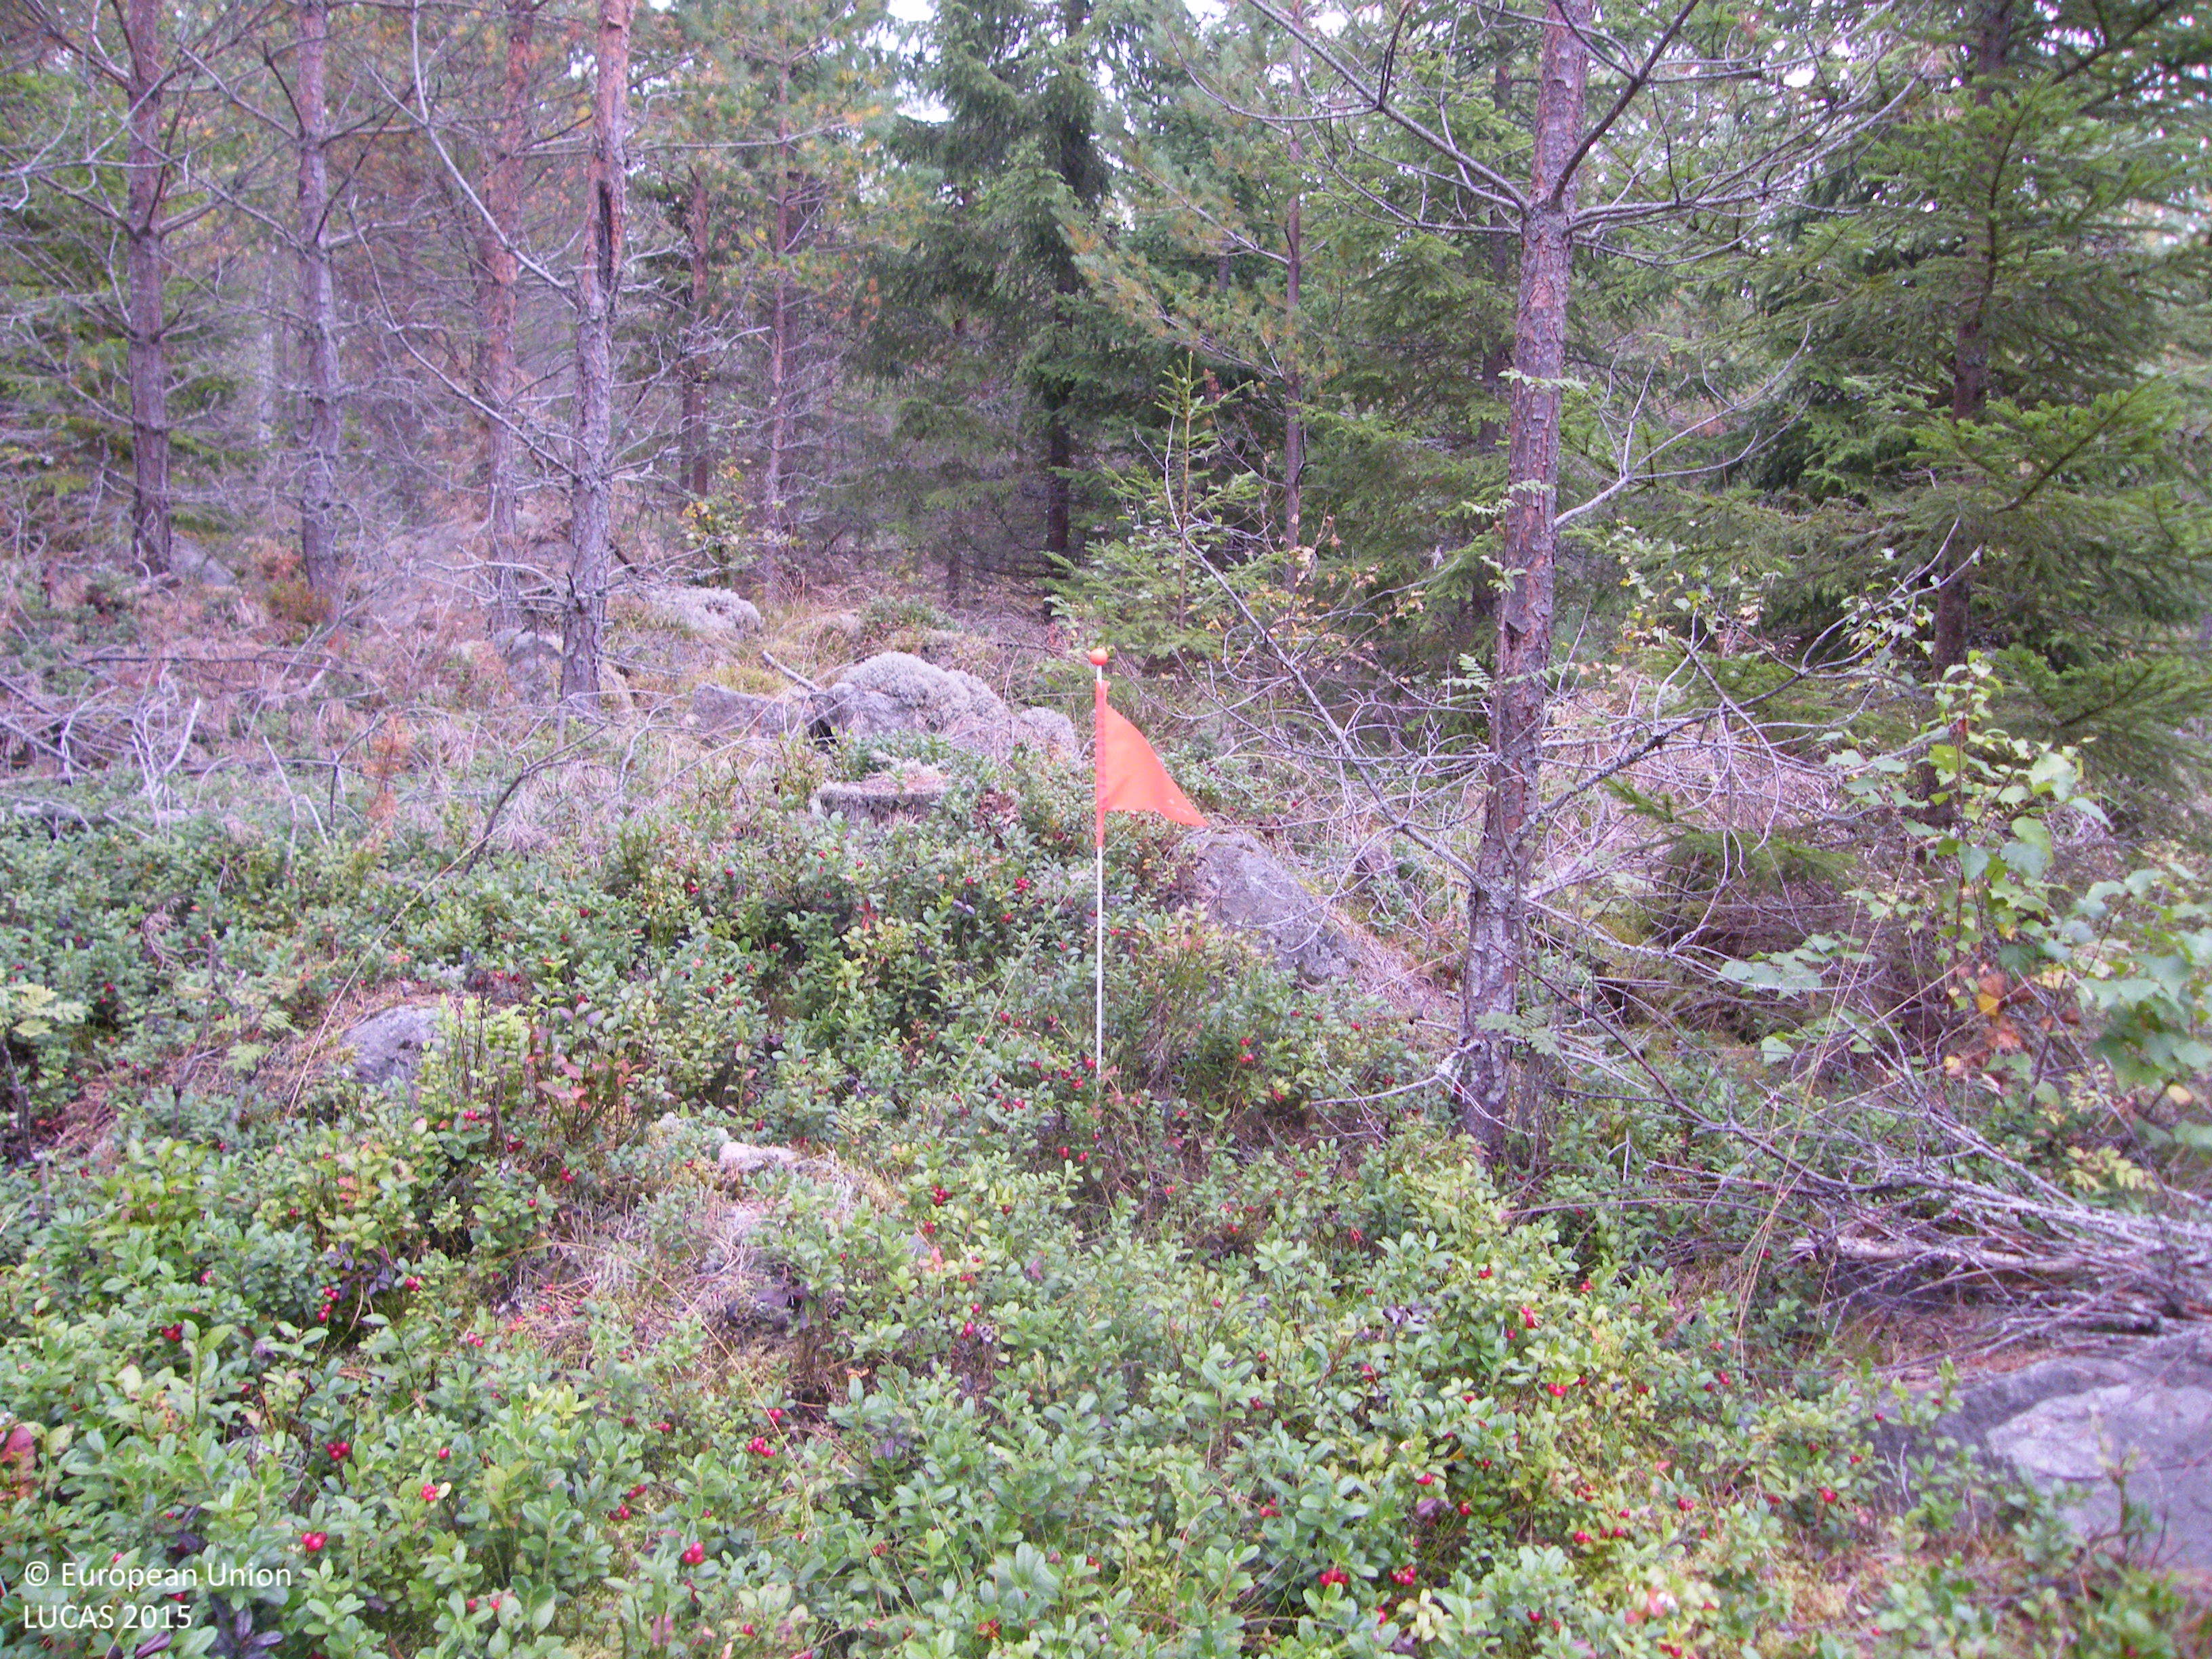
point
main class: Woodland
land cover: Pine dominated coniferous woodland
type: boreal forest
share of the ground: 50 - 75 %
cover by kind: coniferous forest trees 65 %, shrubs 20 %, lichens and mosses 10 %, broadleaved forest trees 5 %
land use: Forestry
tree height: > 5 m
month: September
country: SE
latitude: 59.5655
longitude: 15.5660
